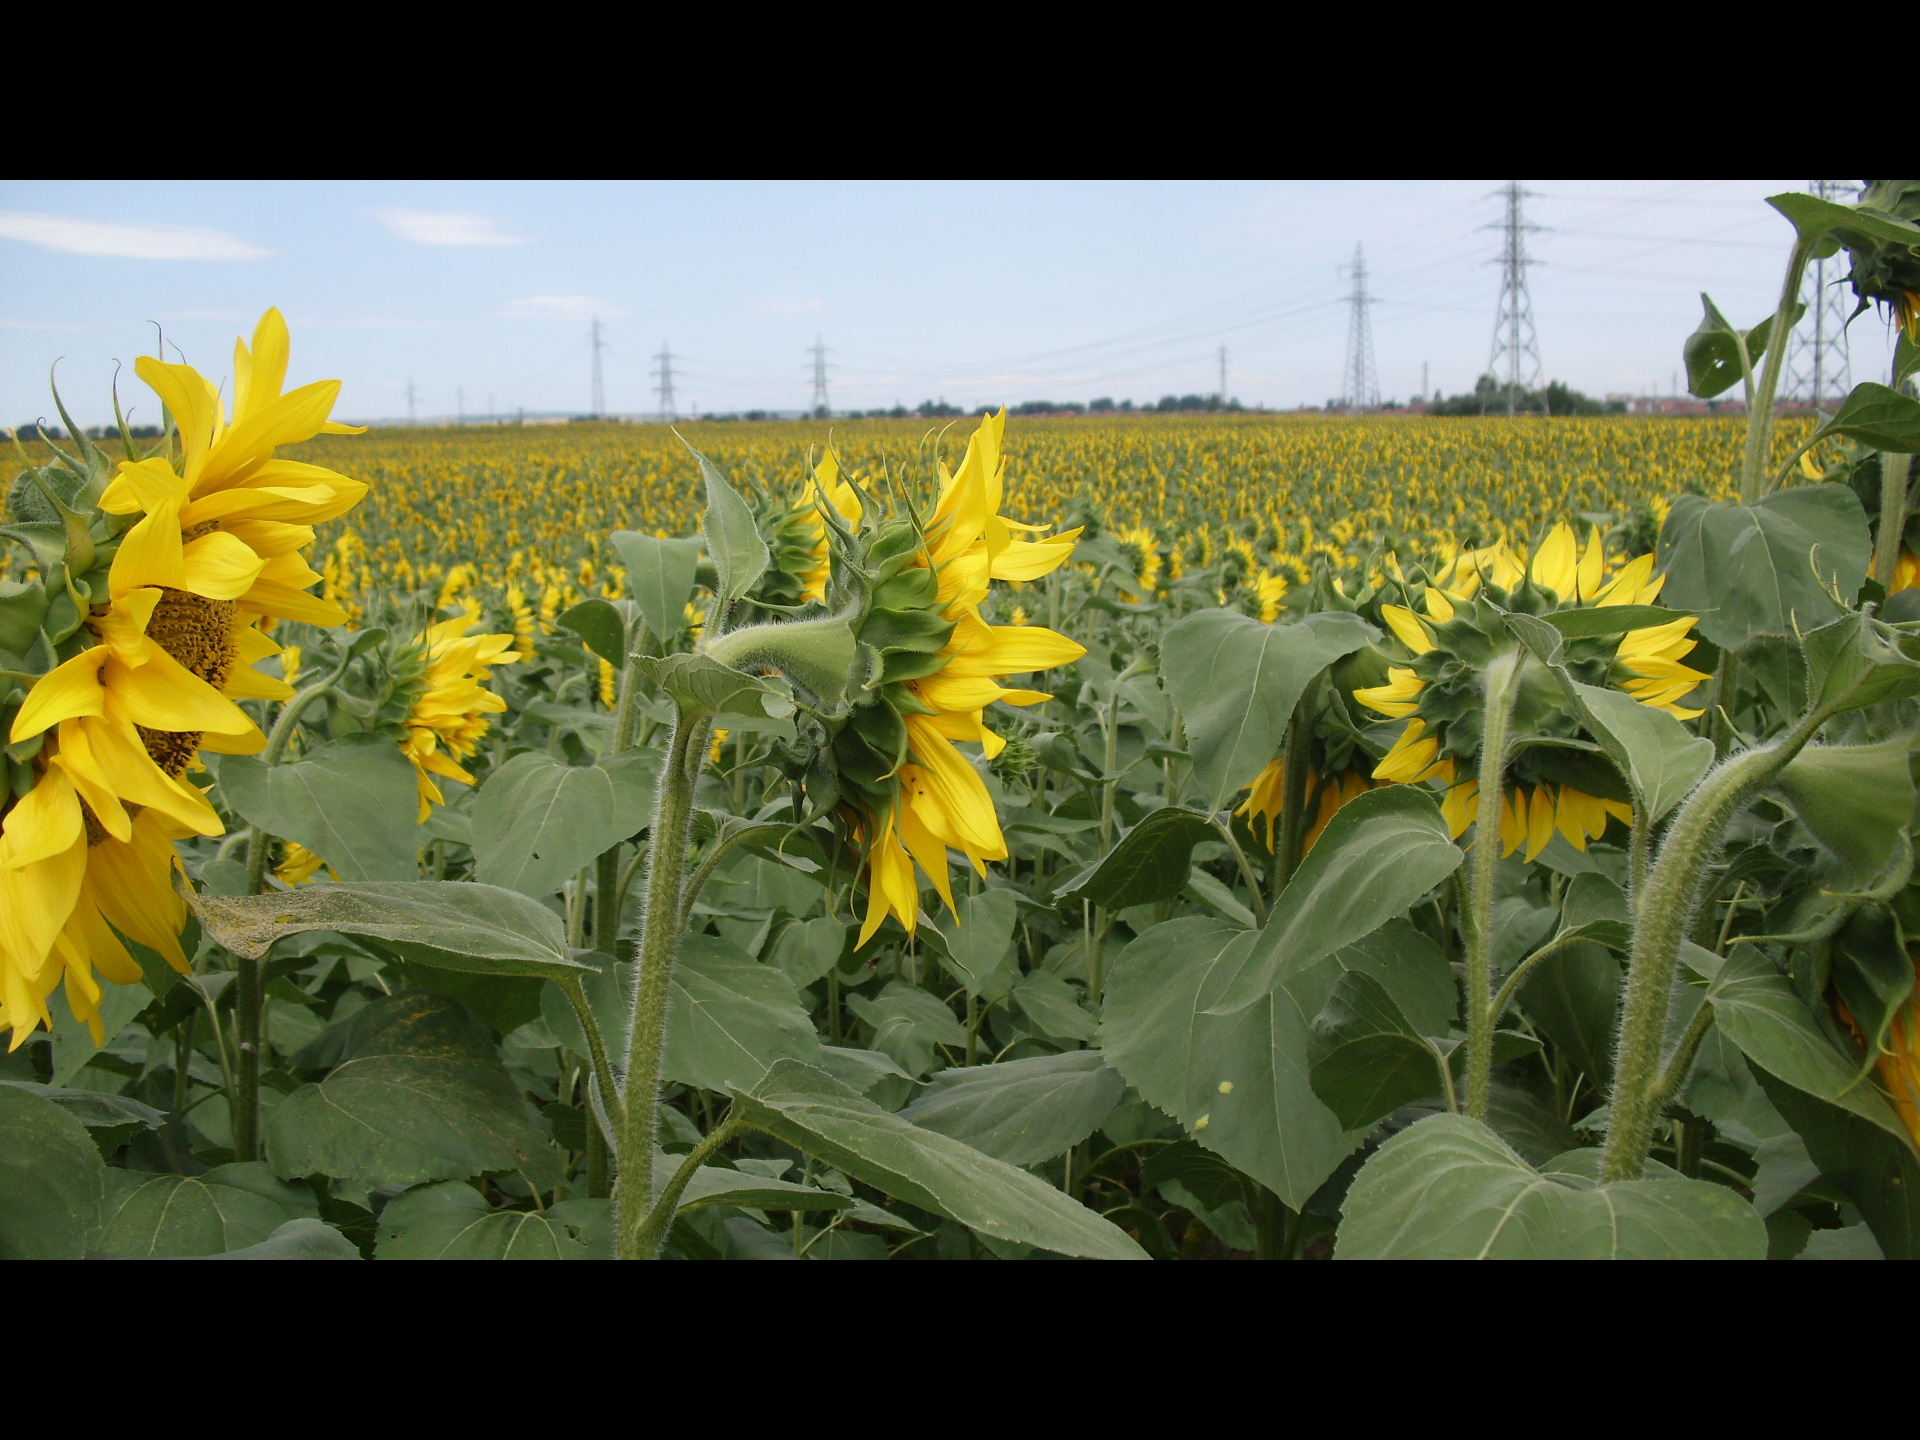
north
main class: Cropland
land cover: Sunflower
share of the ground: > 75 %
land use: Agriculture (excluding fallow land and kitchen gardens)
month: July
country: BG
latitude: 43.9688
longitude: 22.8398
